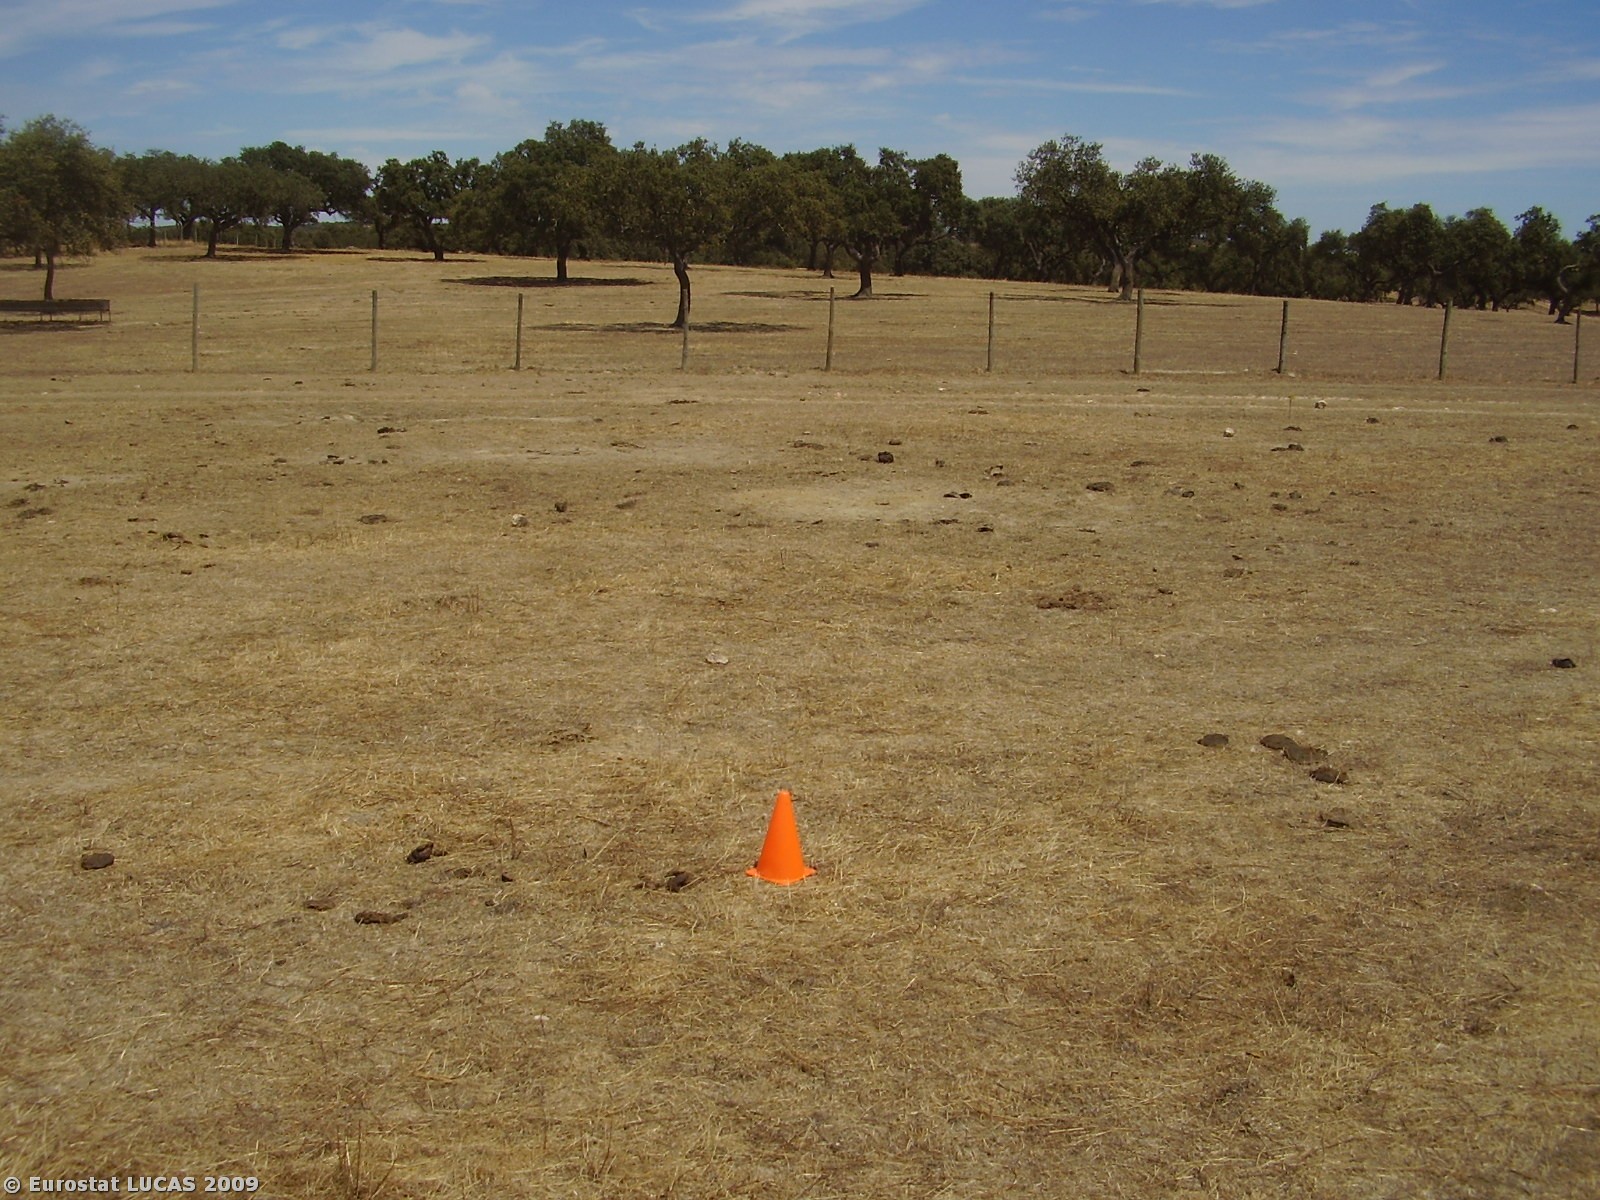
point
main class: Woodland
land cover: Broadleaved woodland
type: broadleaved evergreen forest
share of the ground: 10 - 25 %
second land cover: Grassland with sparse tree/shrub cover
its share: > 75 %
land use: Forestry
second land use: Fallow land
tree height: > 5 m
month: August
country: PT
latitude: 38.2607
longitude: -7.1712
